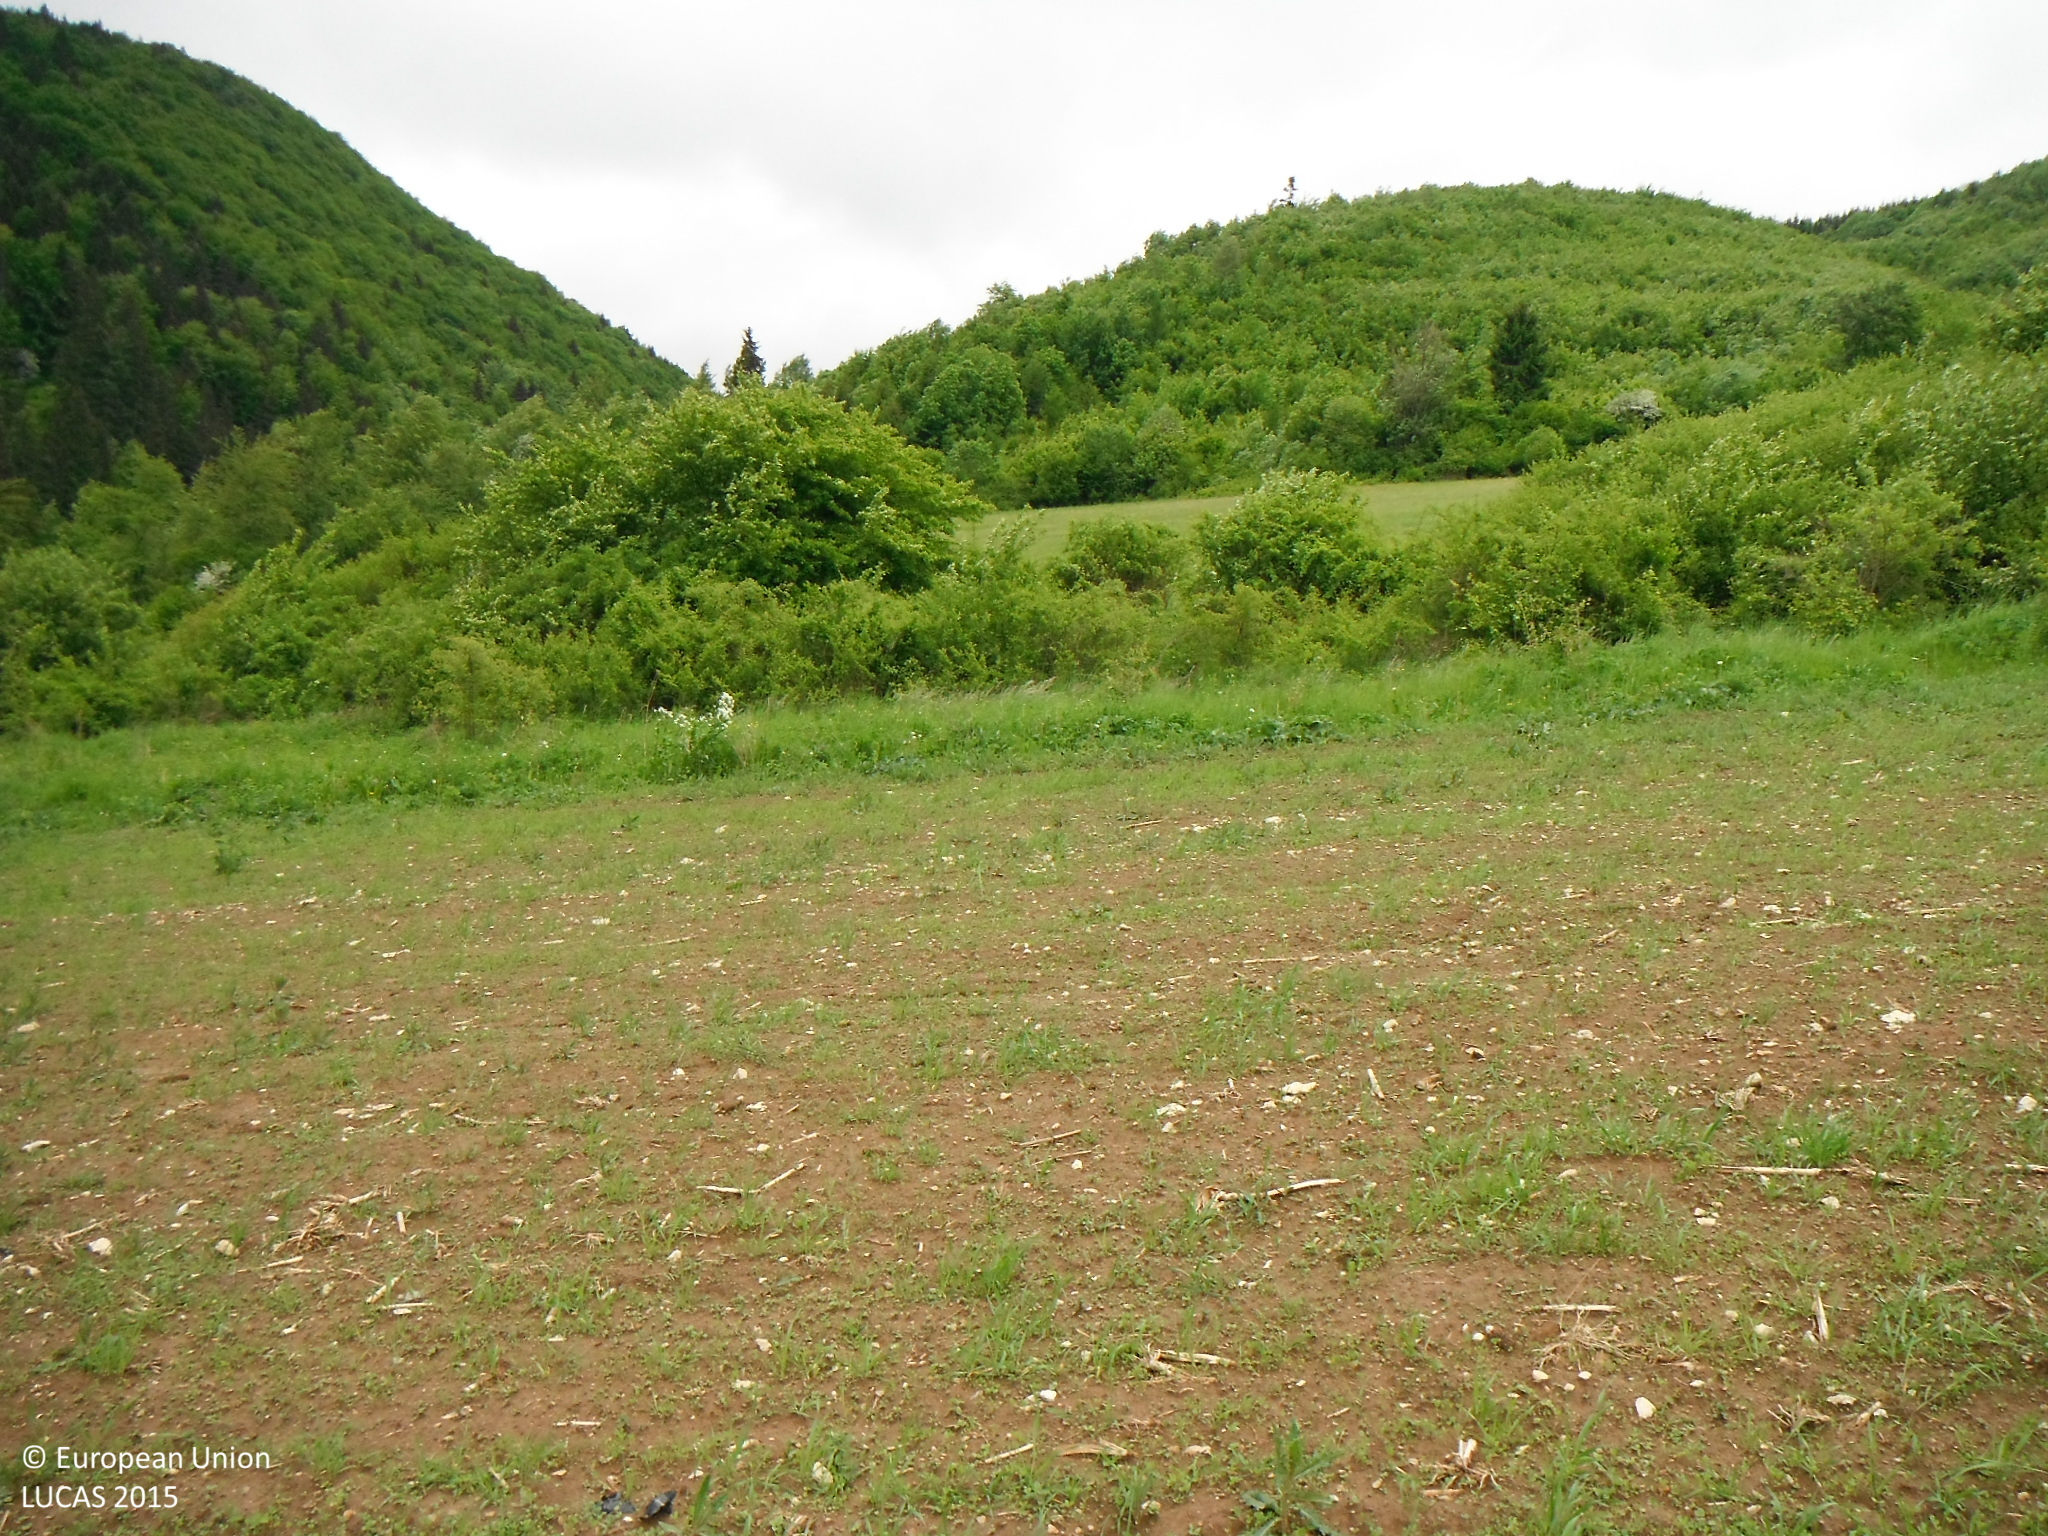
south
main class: Cropland
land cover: Common wheat
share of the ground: 25 - 50 %
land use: Agriculture (excluding fallow land and kitchen gardens)
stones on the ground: 10 - 25 %
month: May
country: SK
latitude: 49.0821
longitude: 19.0448
